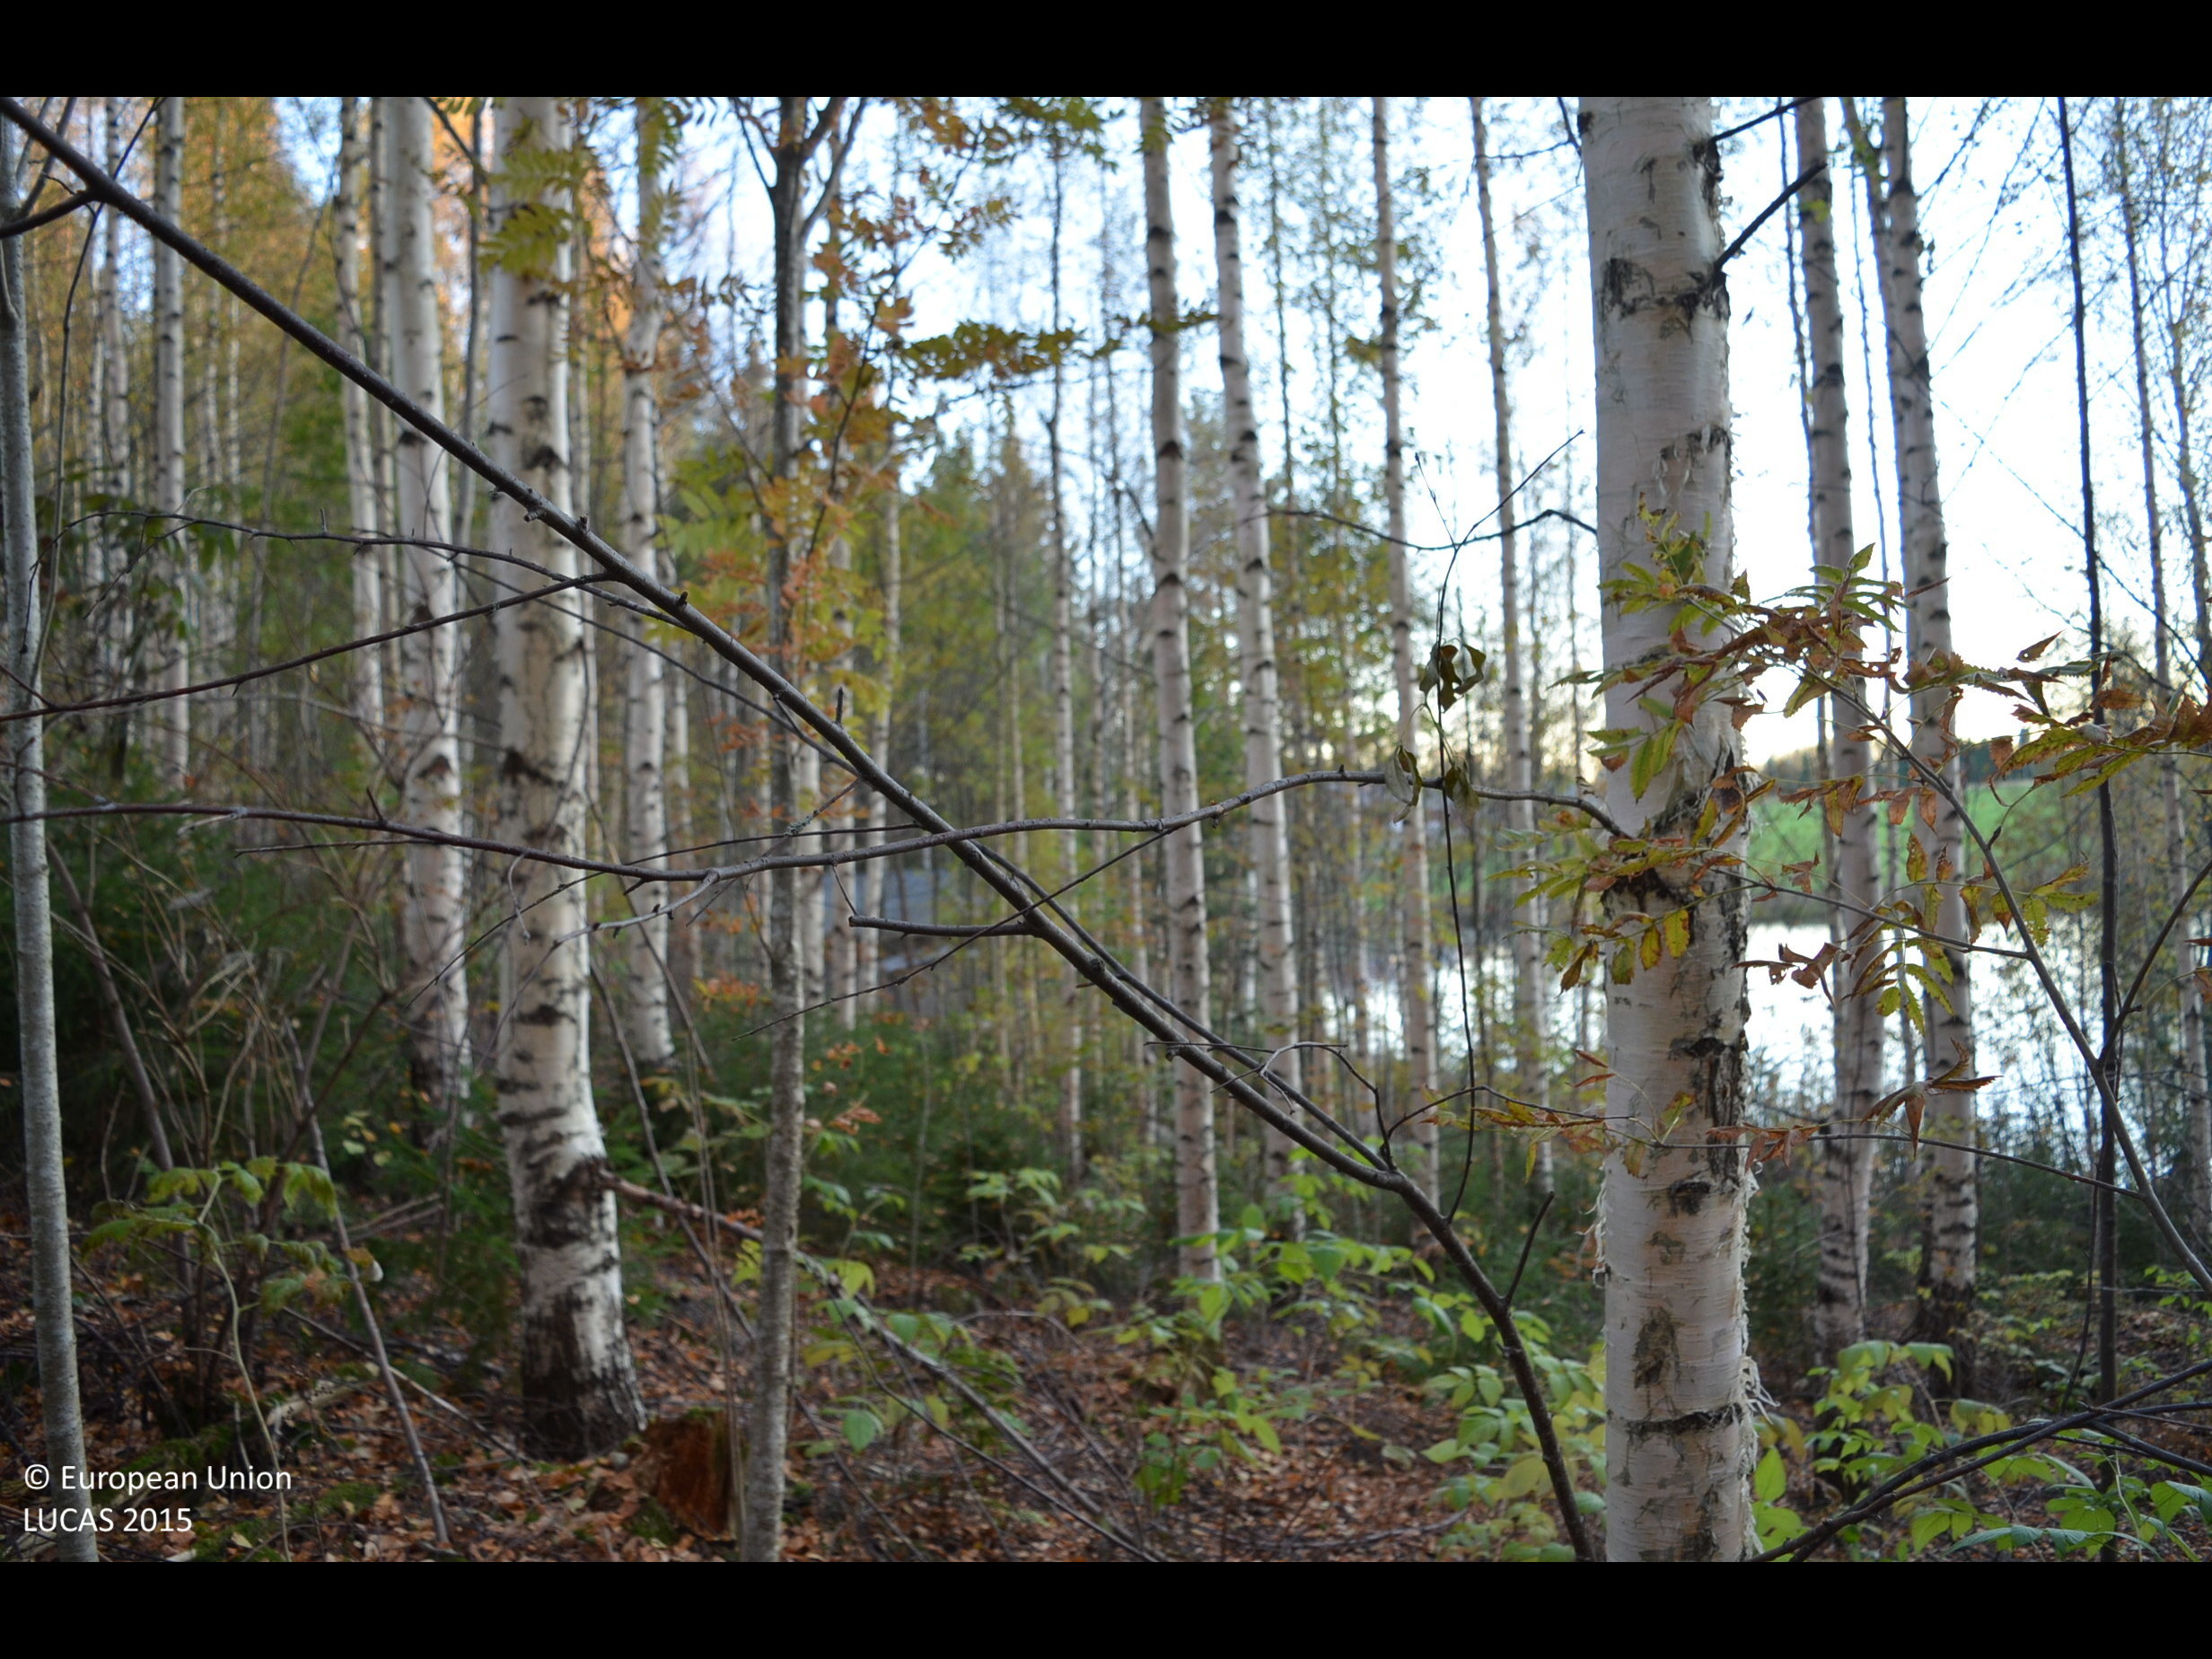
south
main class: Woodland
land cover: Broadleaved woodland
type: boreal forest
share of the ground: > 75 %
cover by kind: broadleaved forest trees 80 %, coniferous forest trees 5 %, shrubs 5 %
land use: Forestry
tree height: > 5 m
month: October
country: FI
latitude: 61.8287
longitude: 23.9649
